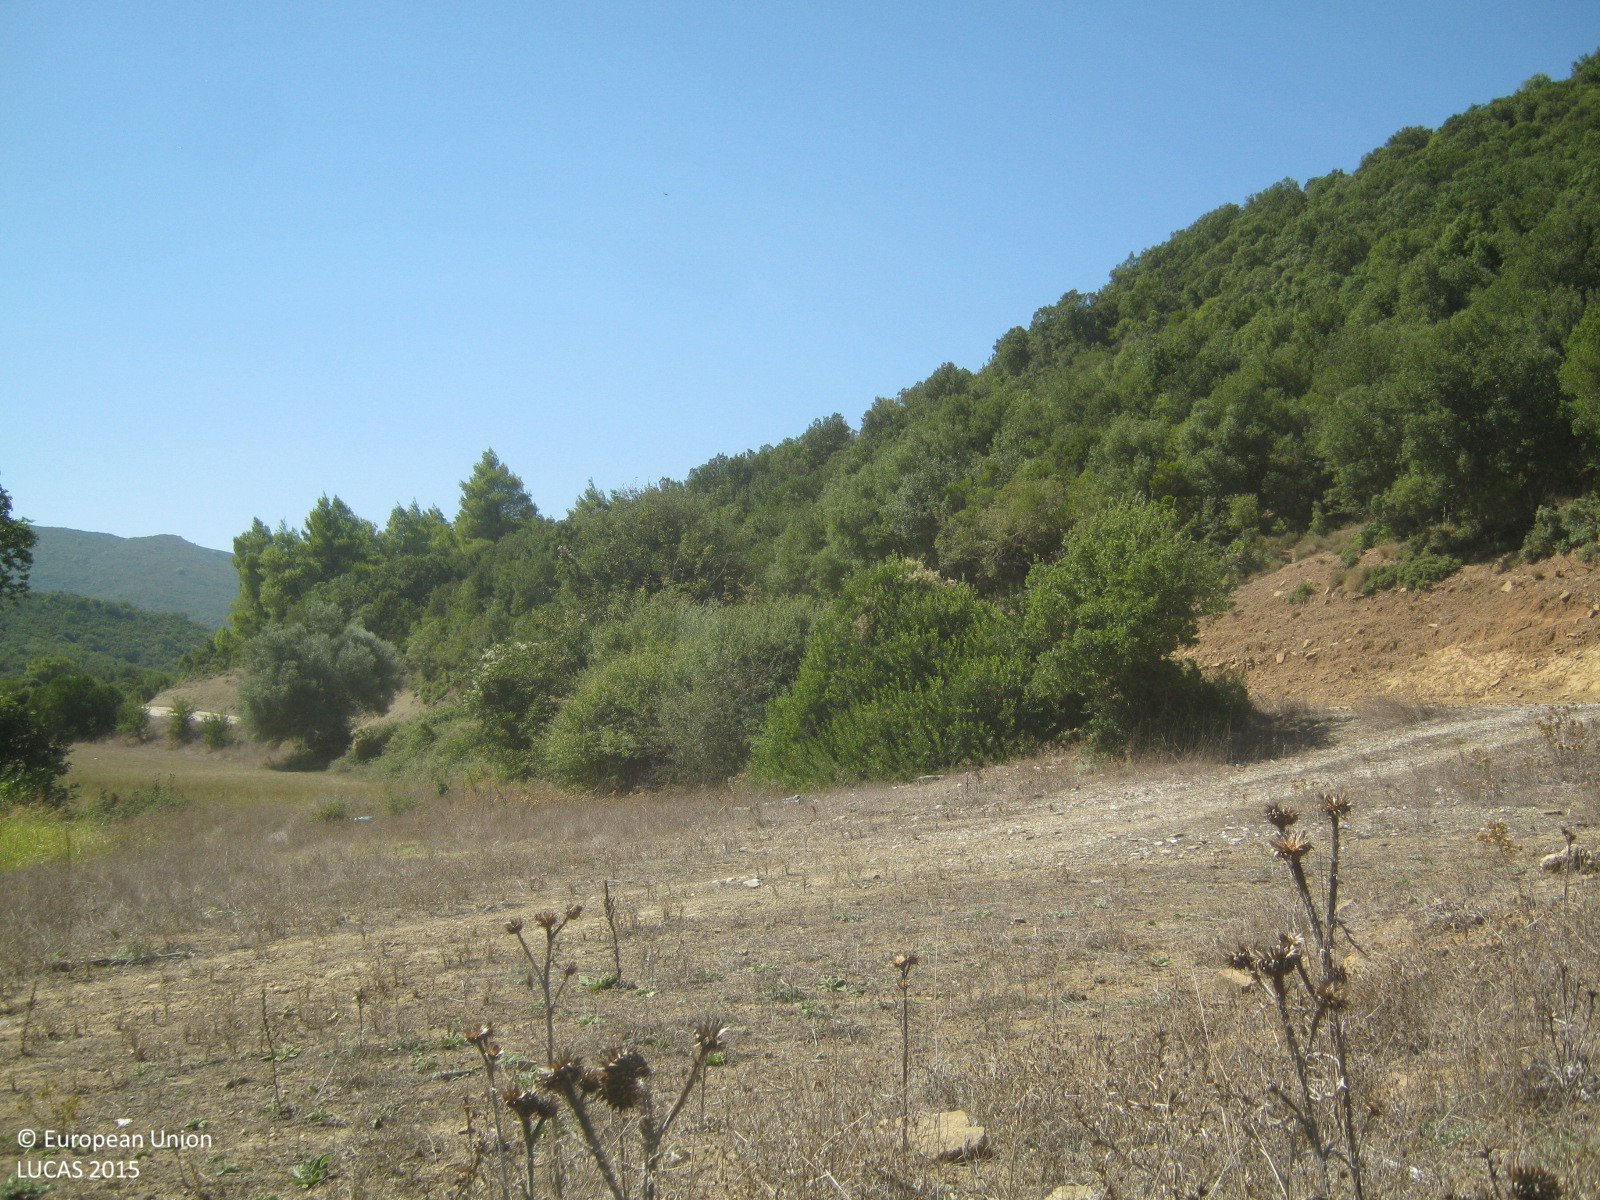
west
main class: Woodland
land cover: Broadleaved woodland
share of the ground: > 75 %
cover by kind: broadleaved forest trees 90 %, shrubs 10 %
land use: Semi-natural and natural areas not in use
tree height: > 5 m
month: September
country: GR
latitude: 38.0129
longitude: 21.6845
